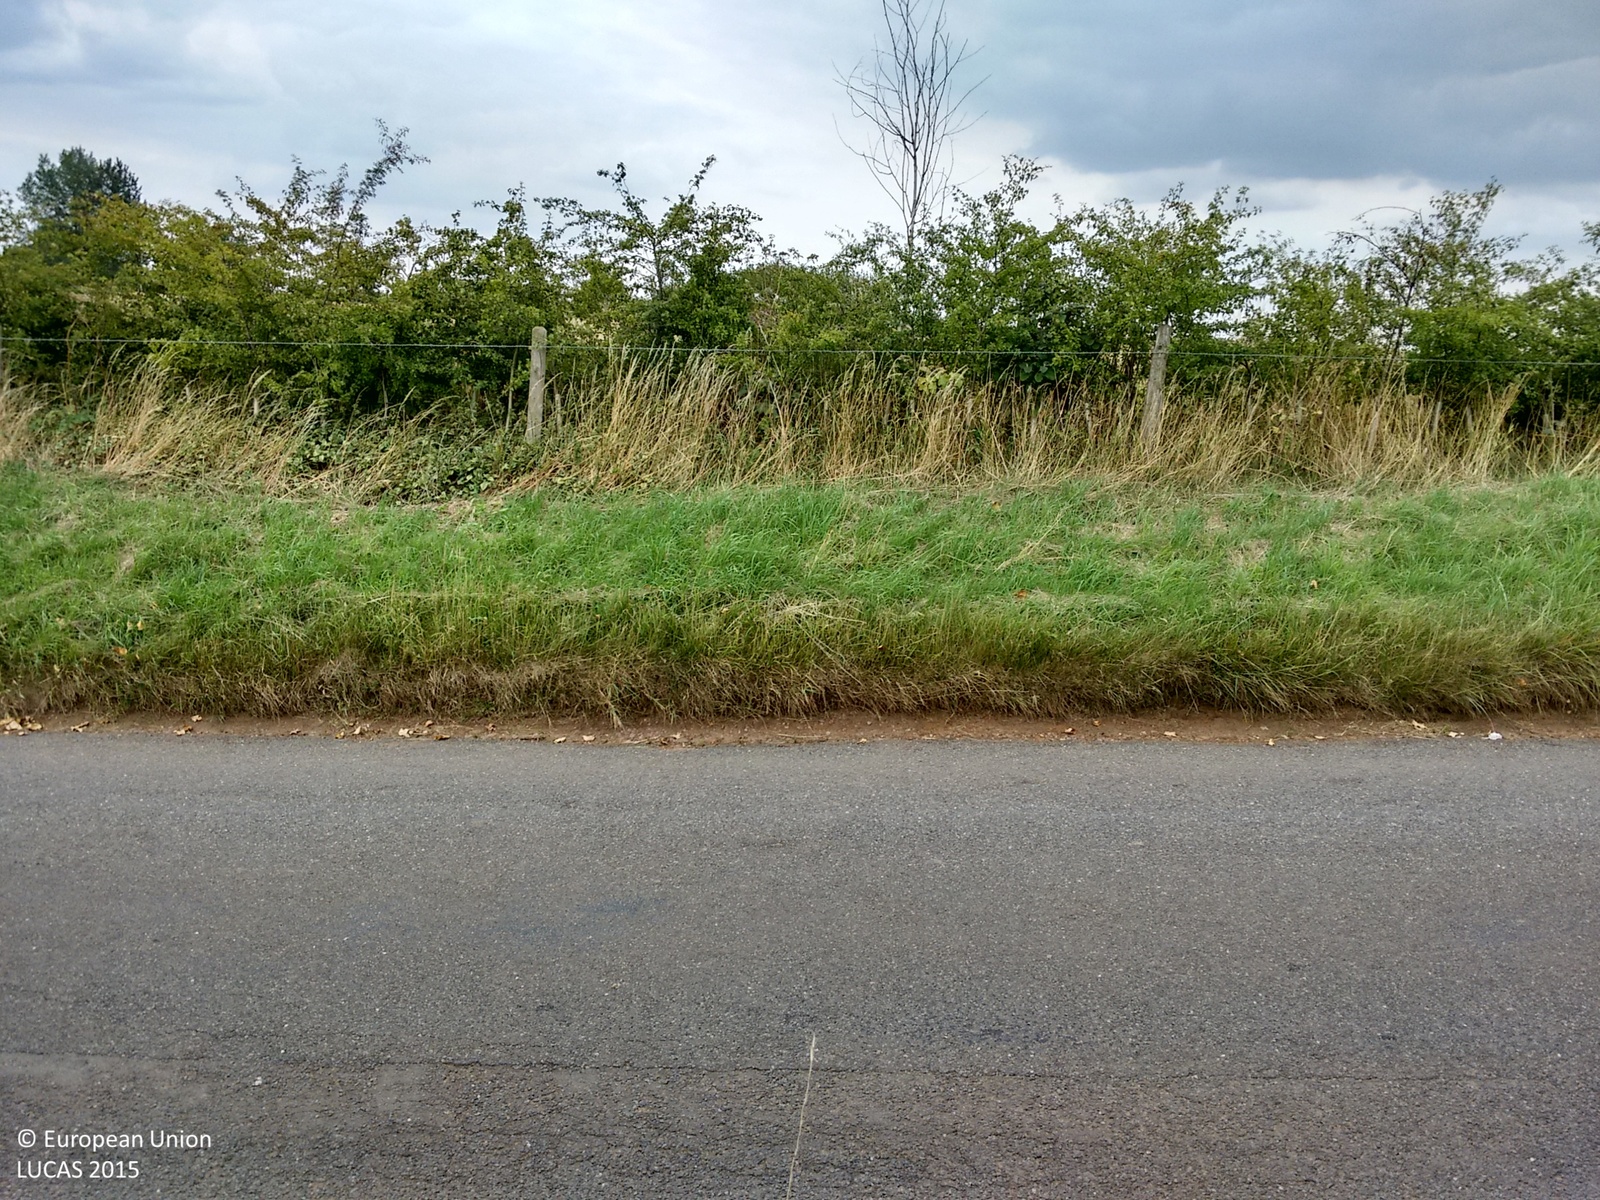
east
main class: Shrubland
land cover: Shrubland with sparse tree cover
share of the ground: > 75 %
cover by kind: shrubs 75 %, herbaceous plants 20 %, broadleaved forest trees 5 %
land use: Semi-natural and natural areas not in use
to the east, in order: Shrubland with sparse tree cover; Grassland with sparse tree/shrub cover; Fences; Grassland with sparse tree/shrub cover; Managed hedges; Fences; Paved roads, cycling and walking lanes; Managed hedges; Grassland without tree/shrub cover; Barley
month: August
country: GB
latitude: 52.4078
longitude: -0.8170
